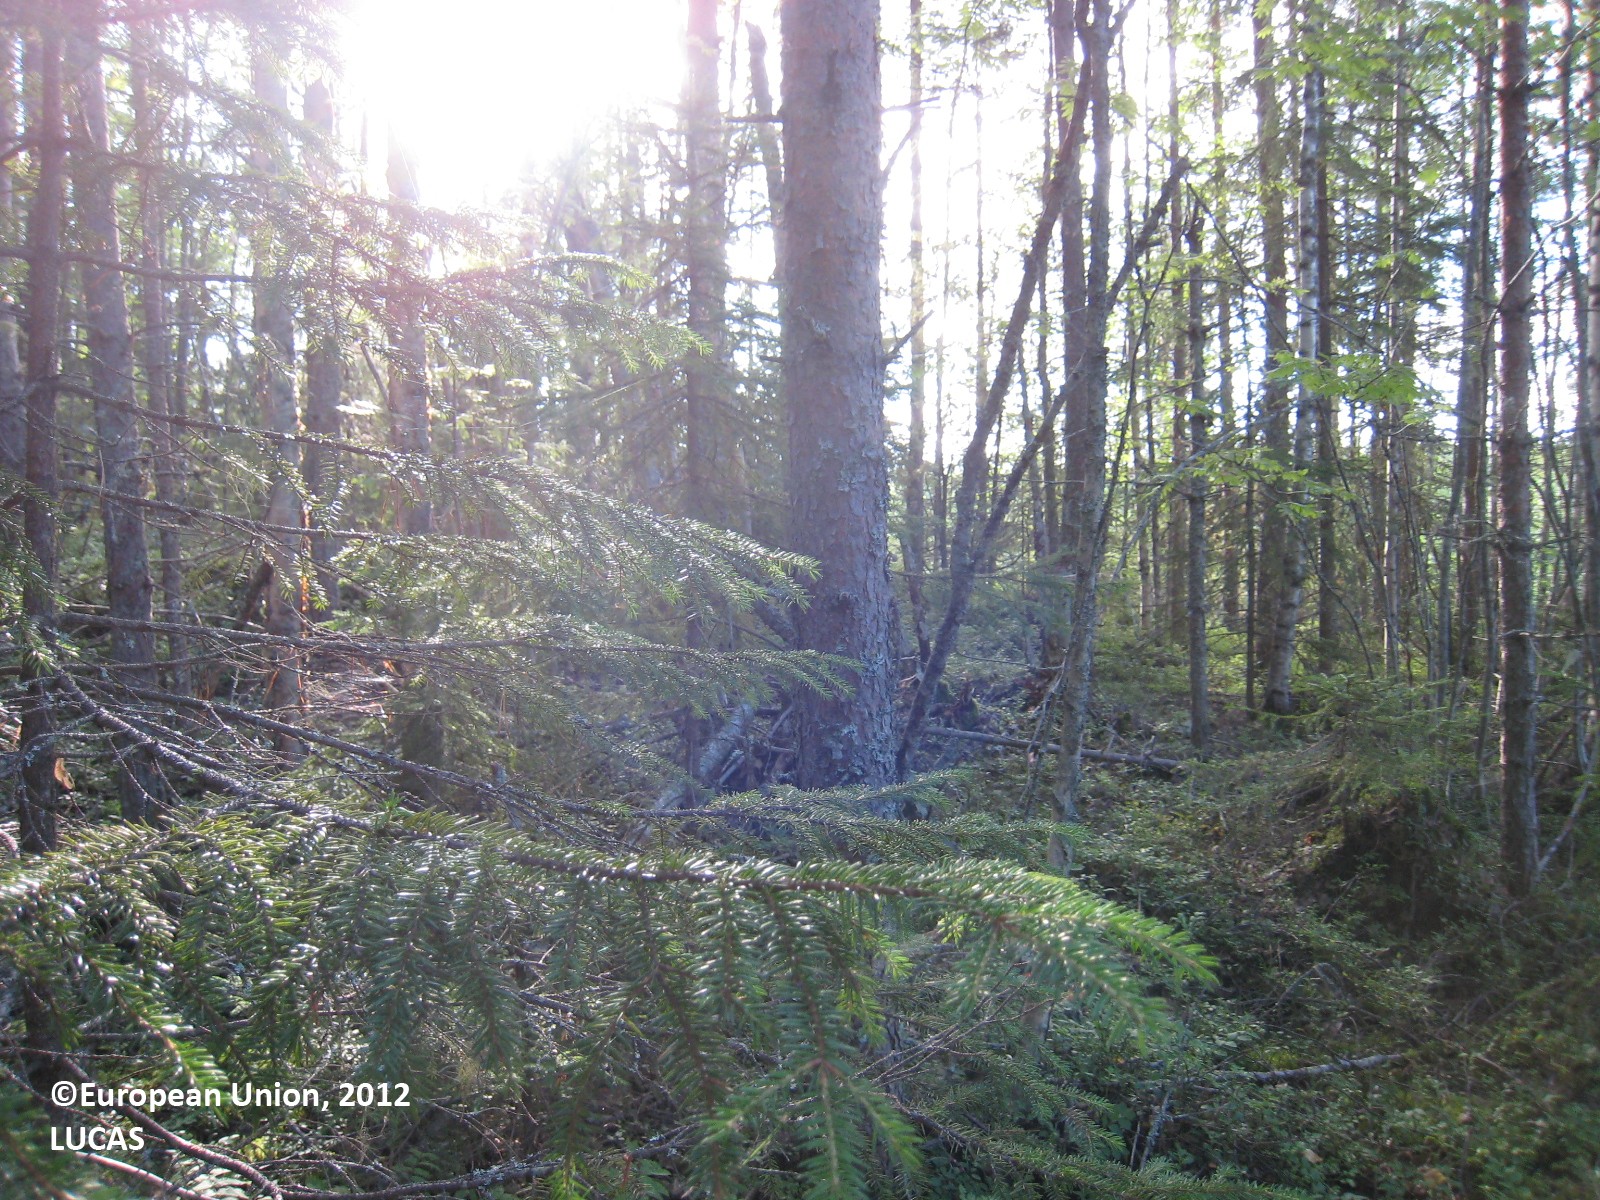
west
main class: Woodland
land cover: Pine dominated mixed woodland
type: boreal forest
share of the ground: > 75 %
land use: Forestry
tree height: > 5 m
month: July
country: FI
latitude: 62.8500
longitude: 26.7389
